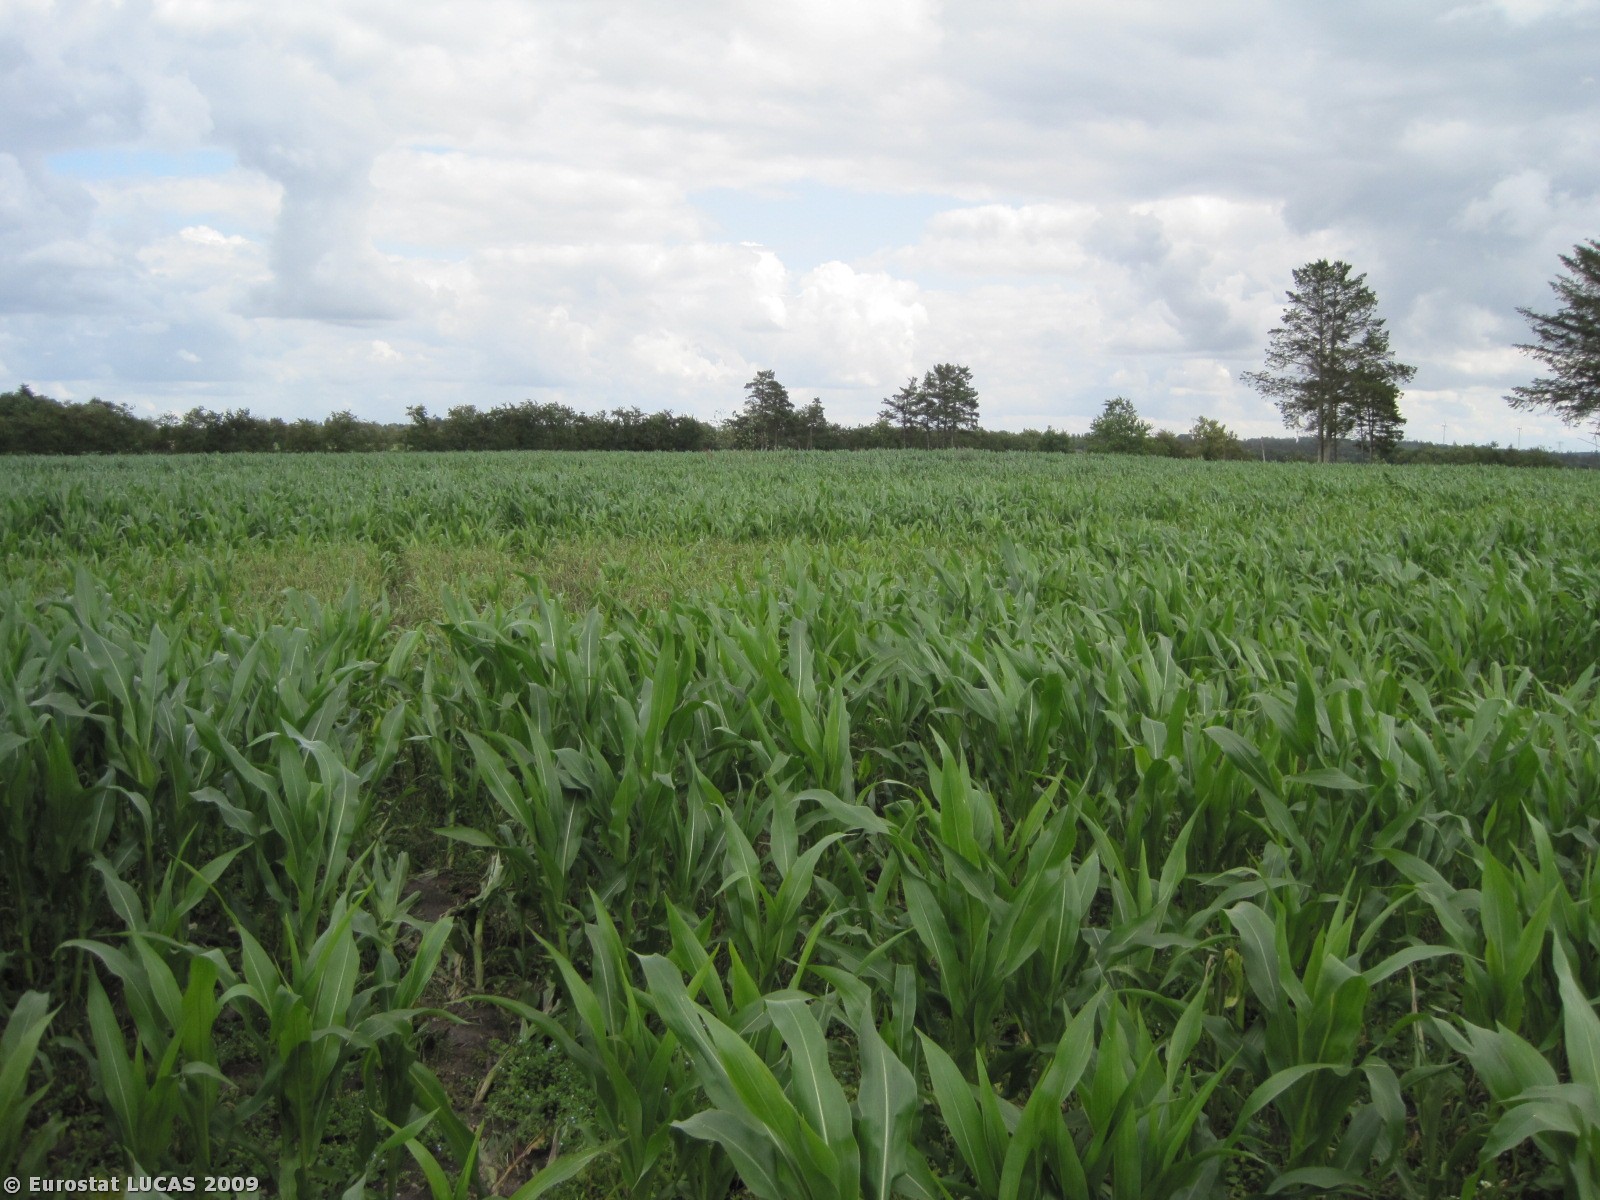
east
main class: Cropland
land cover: Maize
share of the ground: 25 - 50 %
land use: Agriculture (excluding fallow land and kitchen gardens)
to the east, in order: Maize; Grass margins; Abandoned hedges; Grass margins; Maize; Grass margins; Tracks; Grass margins; Barley
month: July
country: DK
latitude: 56.4354
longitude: 8.9796
